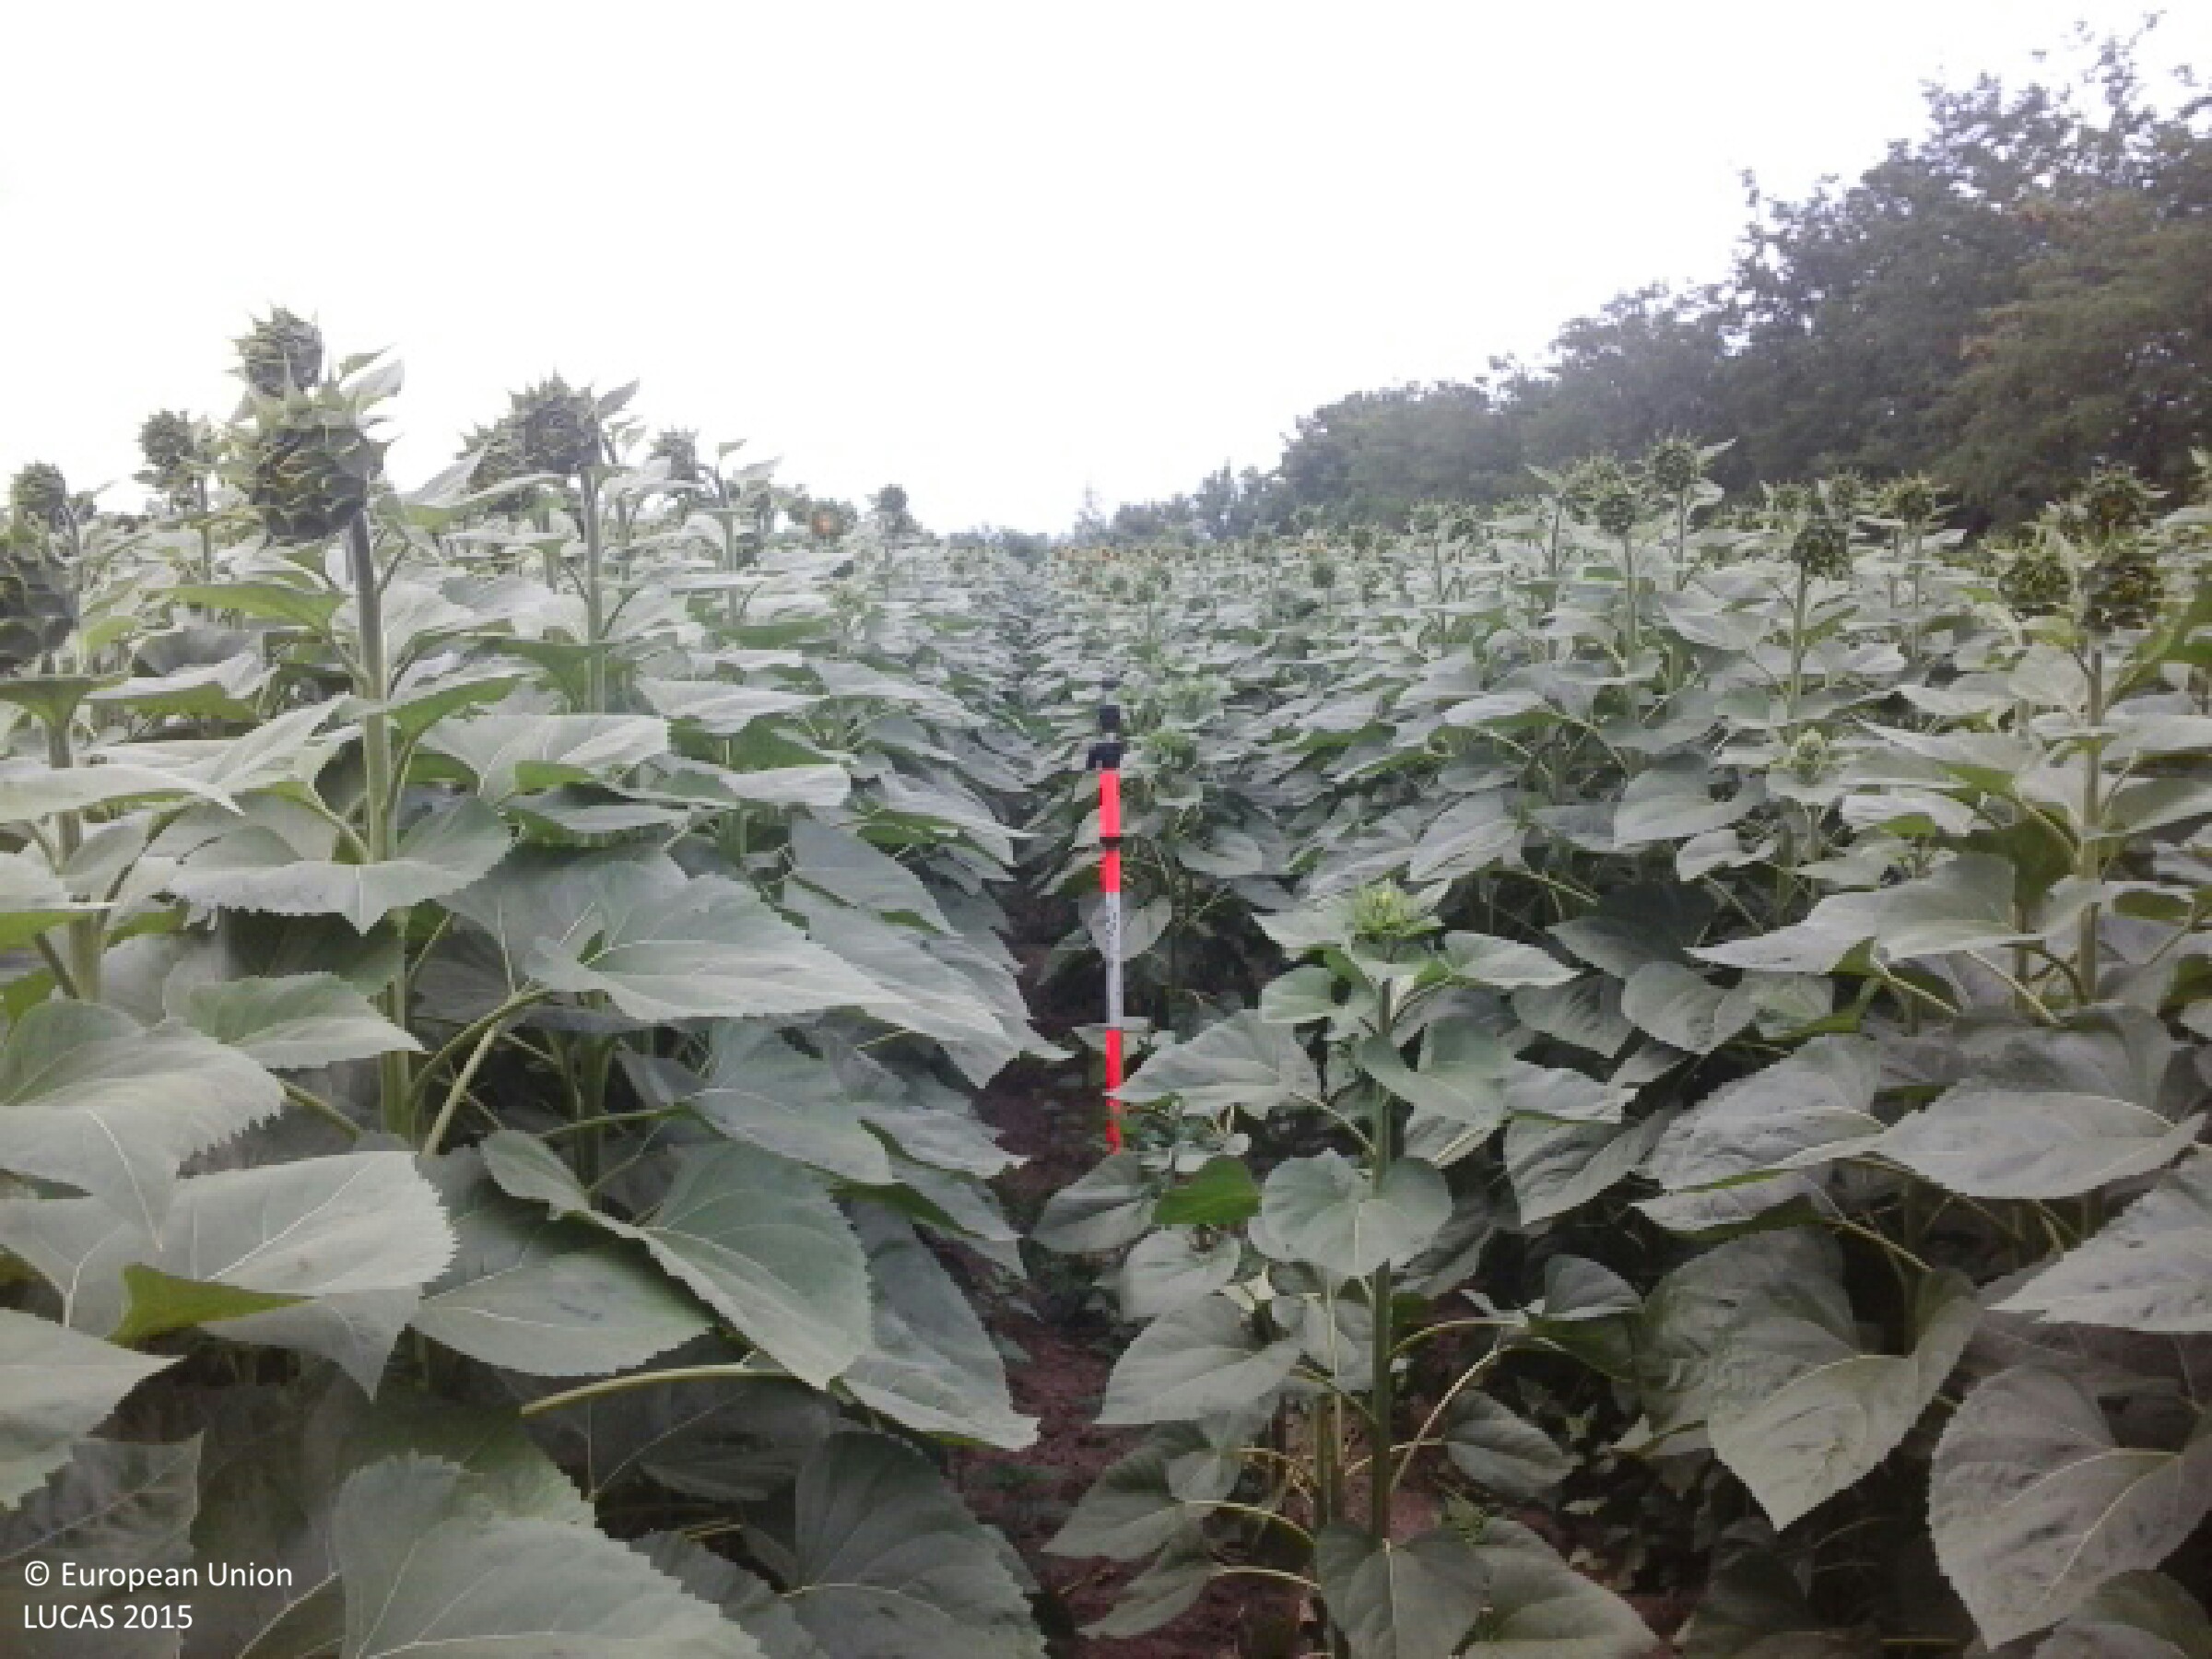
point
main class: Cropland
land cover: Sunflower
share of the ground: > 75 %
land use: Agriculture (excluding fallow land and kitchen gardens)
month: June
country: HU
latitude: 48.1679
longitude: 21.9792
